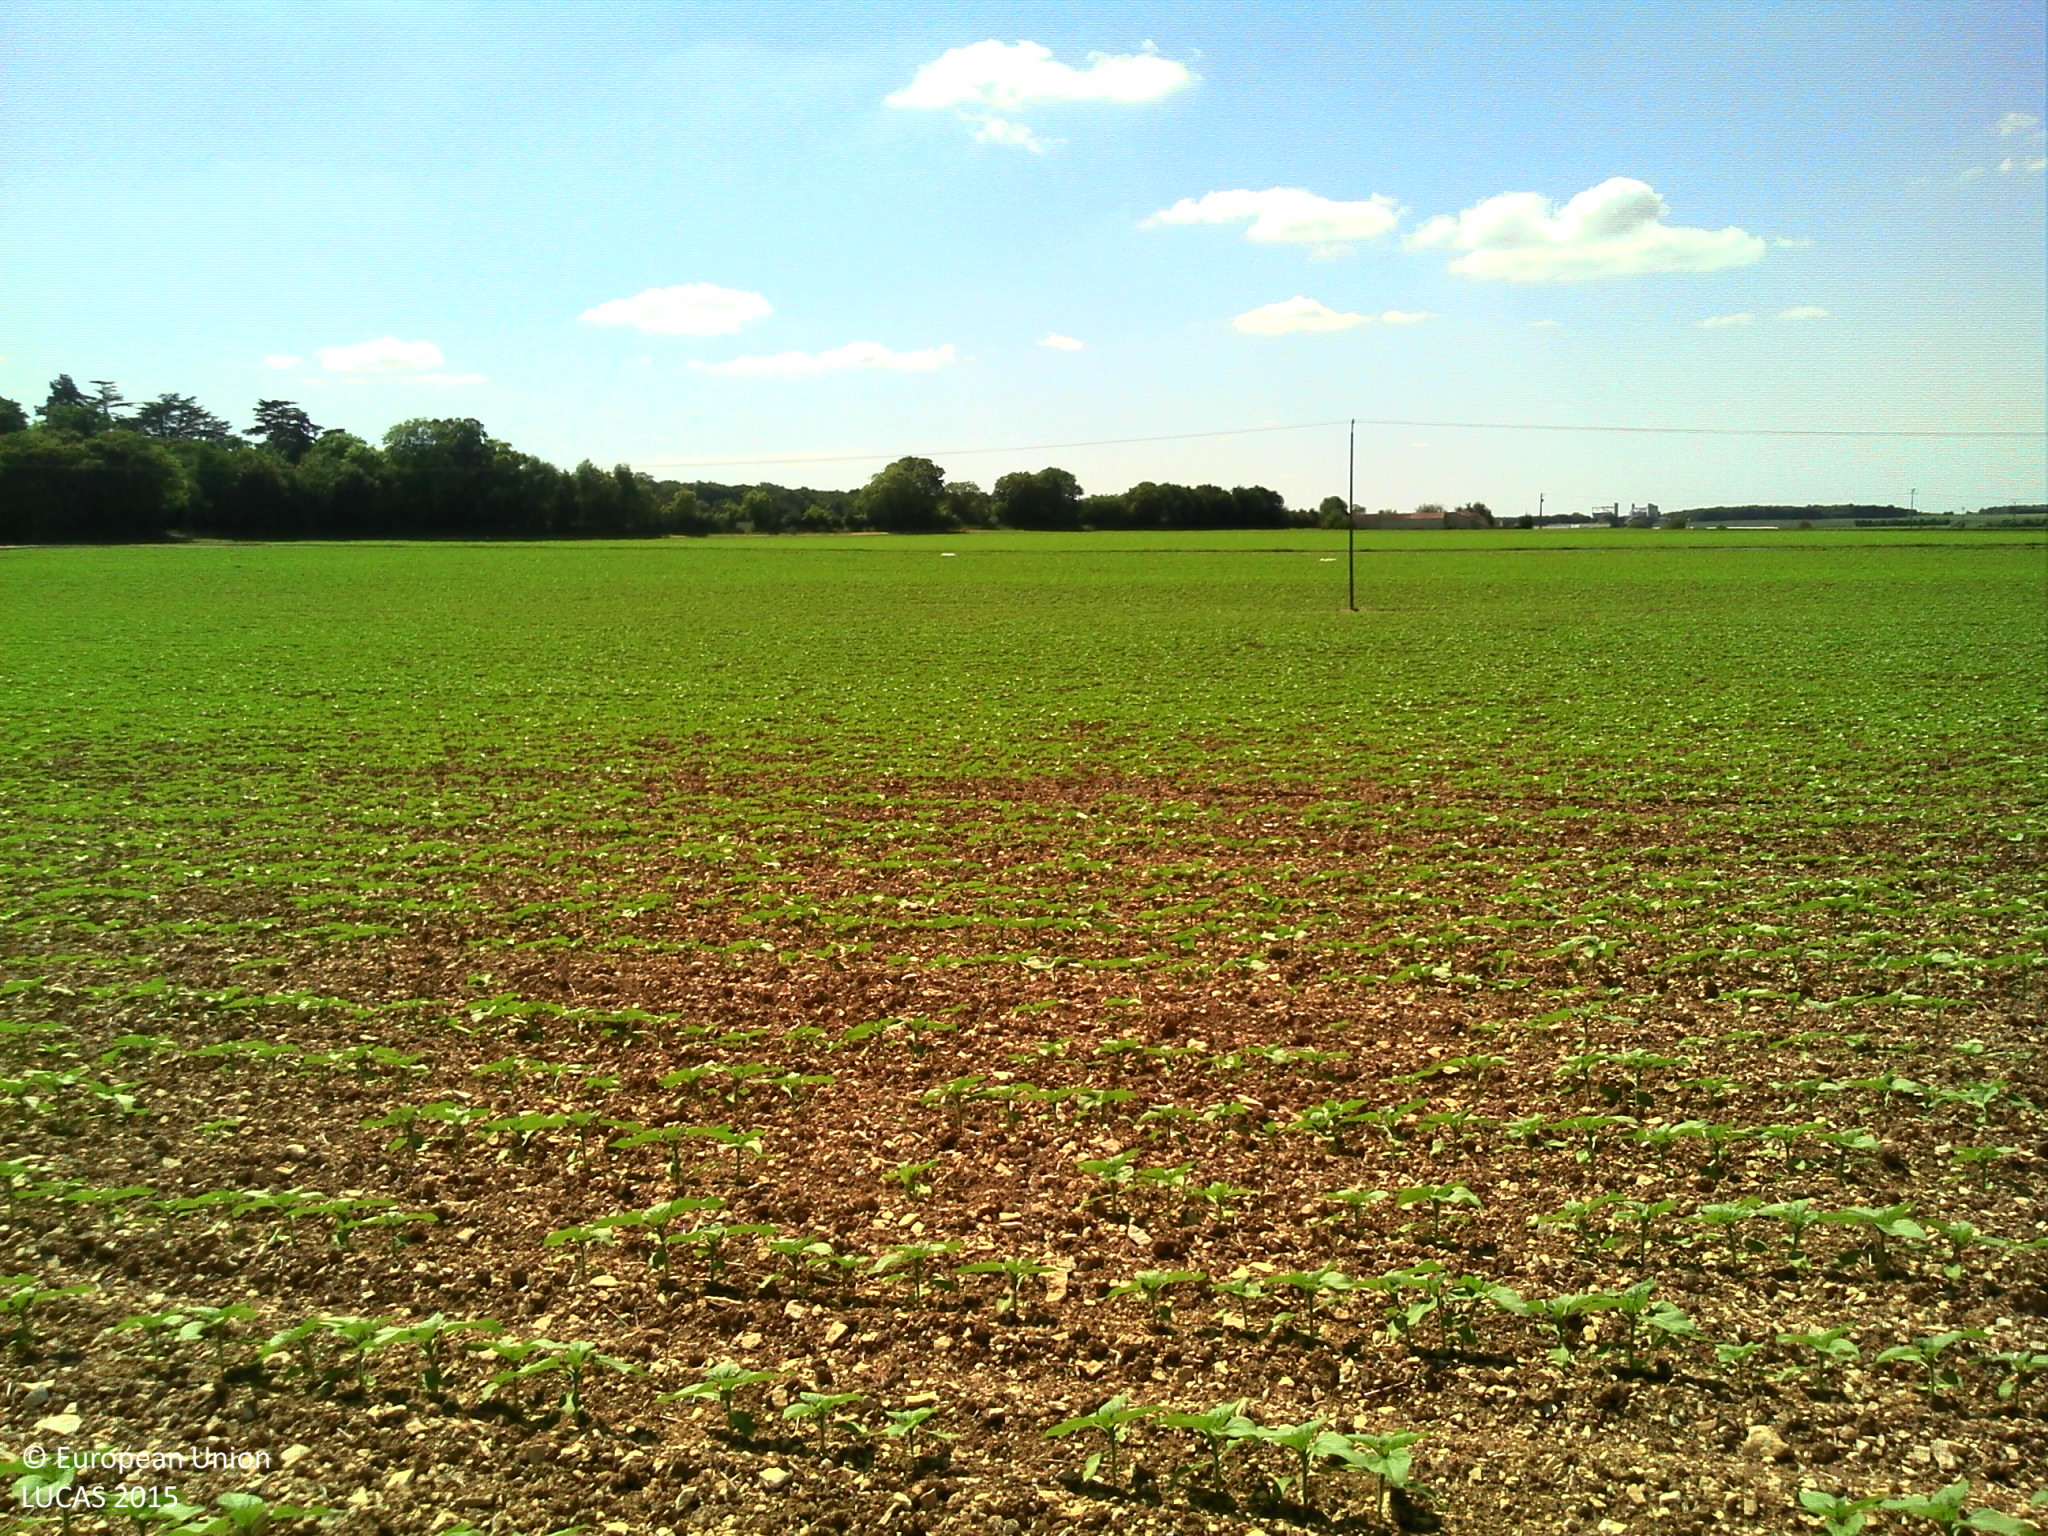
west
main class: Cropland
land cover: Sunflower
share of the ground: 10 - 25 %
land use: Agriculture (excluding fallow land and kitchen gardens)
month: May
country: FR
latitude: 47.0045
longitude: 0.1793
